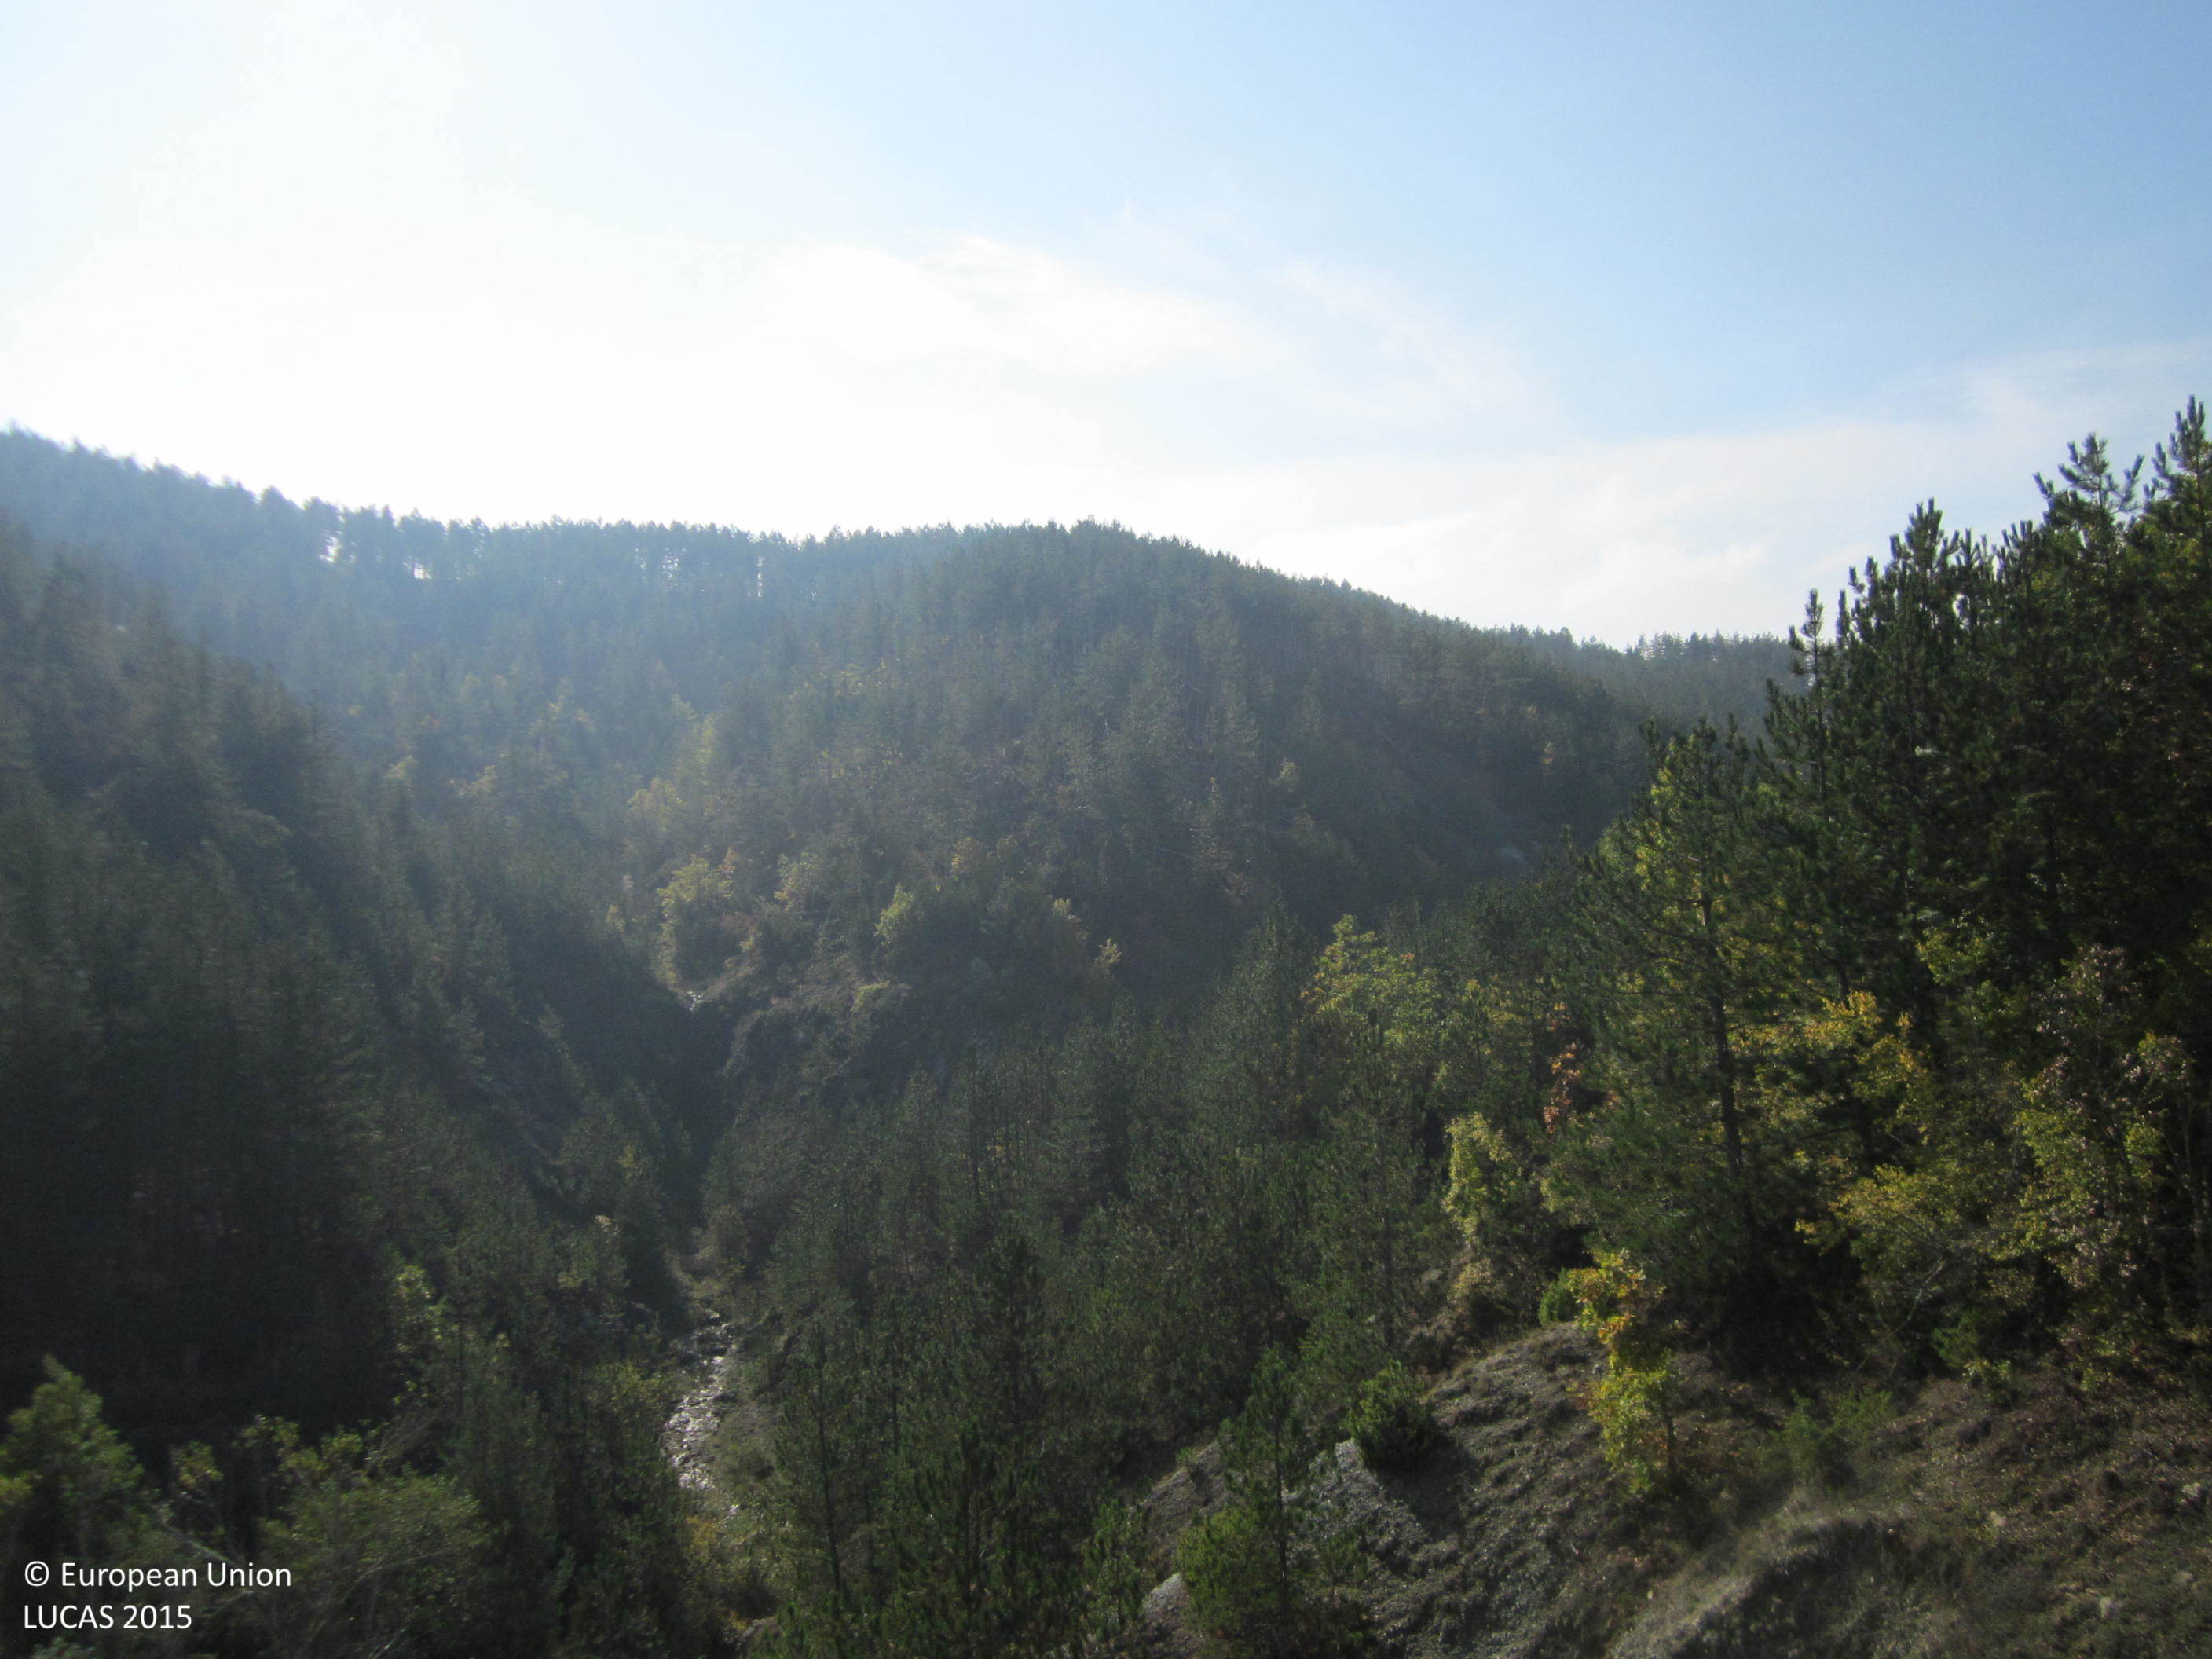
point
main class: Woodland
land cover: Pine dominated mixed woodland
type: hemiboreal forest and nemoral coniferous forest and mixed broadleaved-coniferous forest
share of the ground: 50 - 75 %
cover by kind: coniferous forest trees 50 %, broadleaved forest trees 20 %, unconsolidated bare surface 15 %, herbaceous plants 10 %, shrubs 5 %
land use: Semi-natural and natural areas not in use
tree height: > 5 m
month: October
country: BG
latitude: 41.4322
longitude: 25.6282
